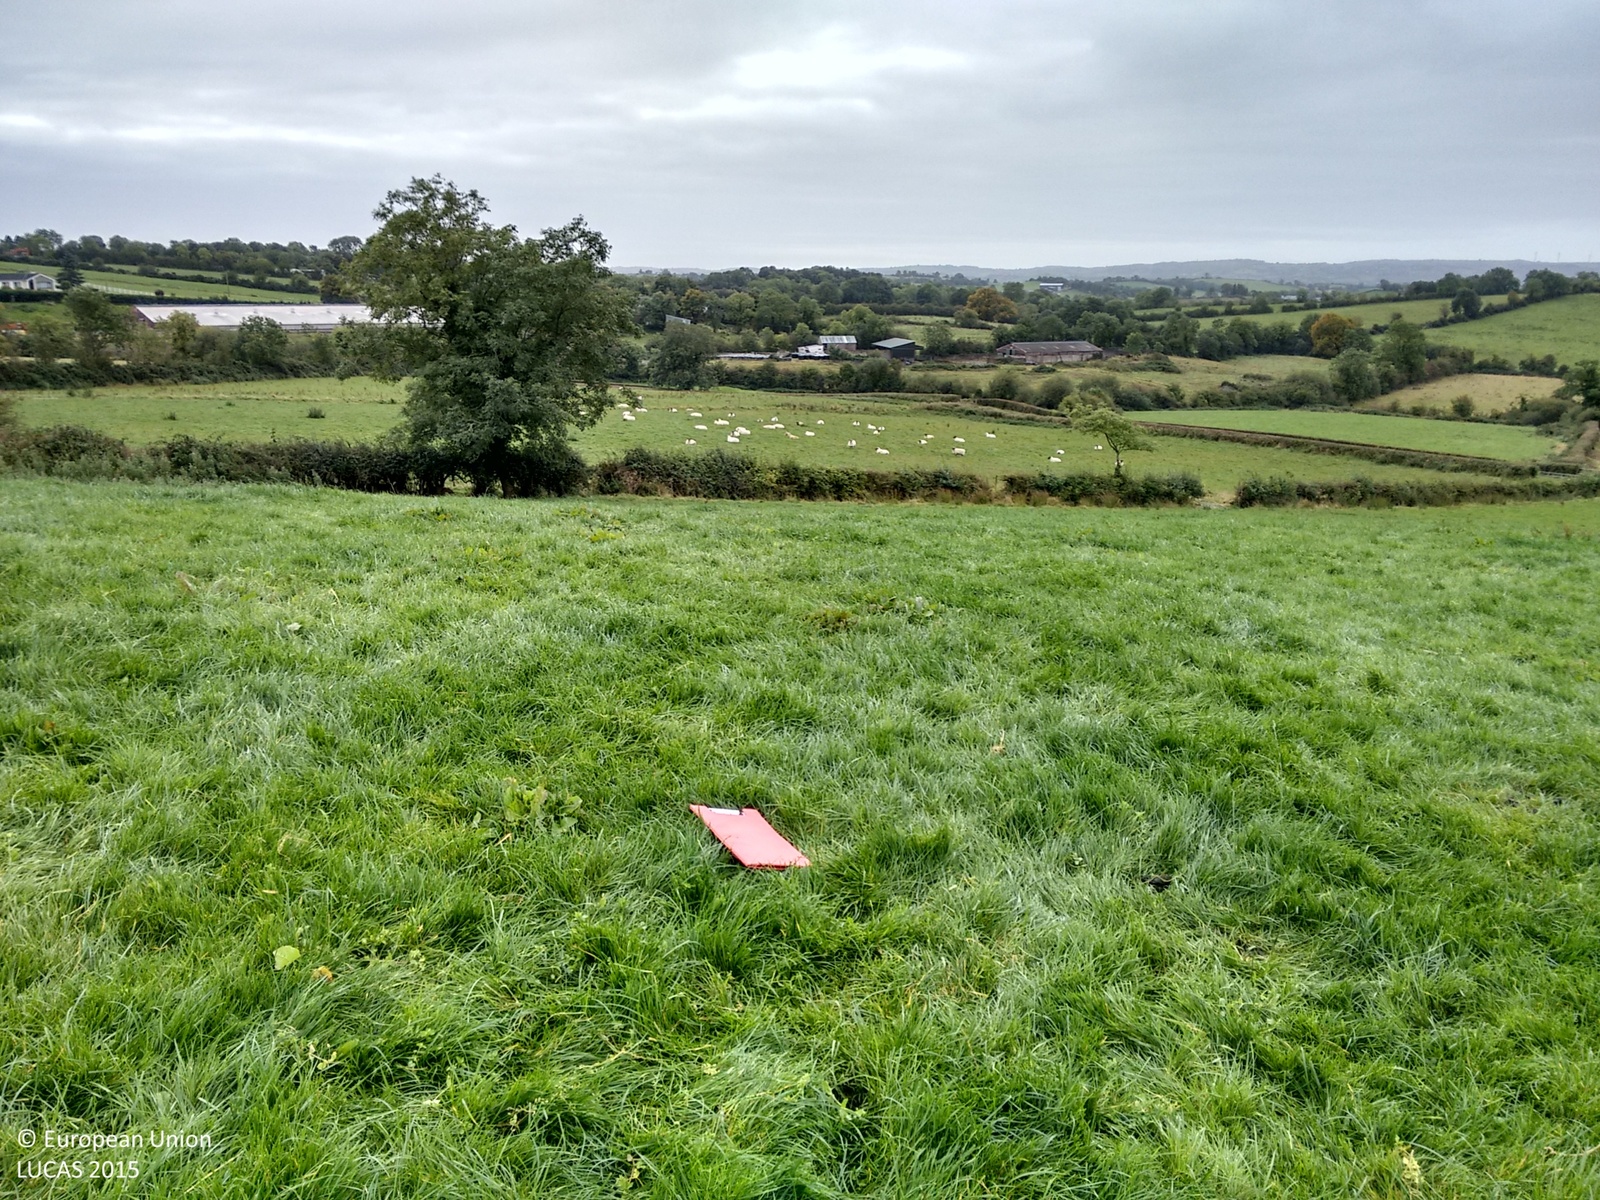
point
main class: Grassland
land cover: Grassland without tree/shrub cover
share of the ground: > 75 %
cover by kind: herbaceous plants 100 %
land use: Agriculture (excluding fallow land and kitchen gardens)
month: September
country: IE
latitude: 54.1688
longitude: -6.9106
